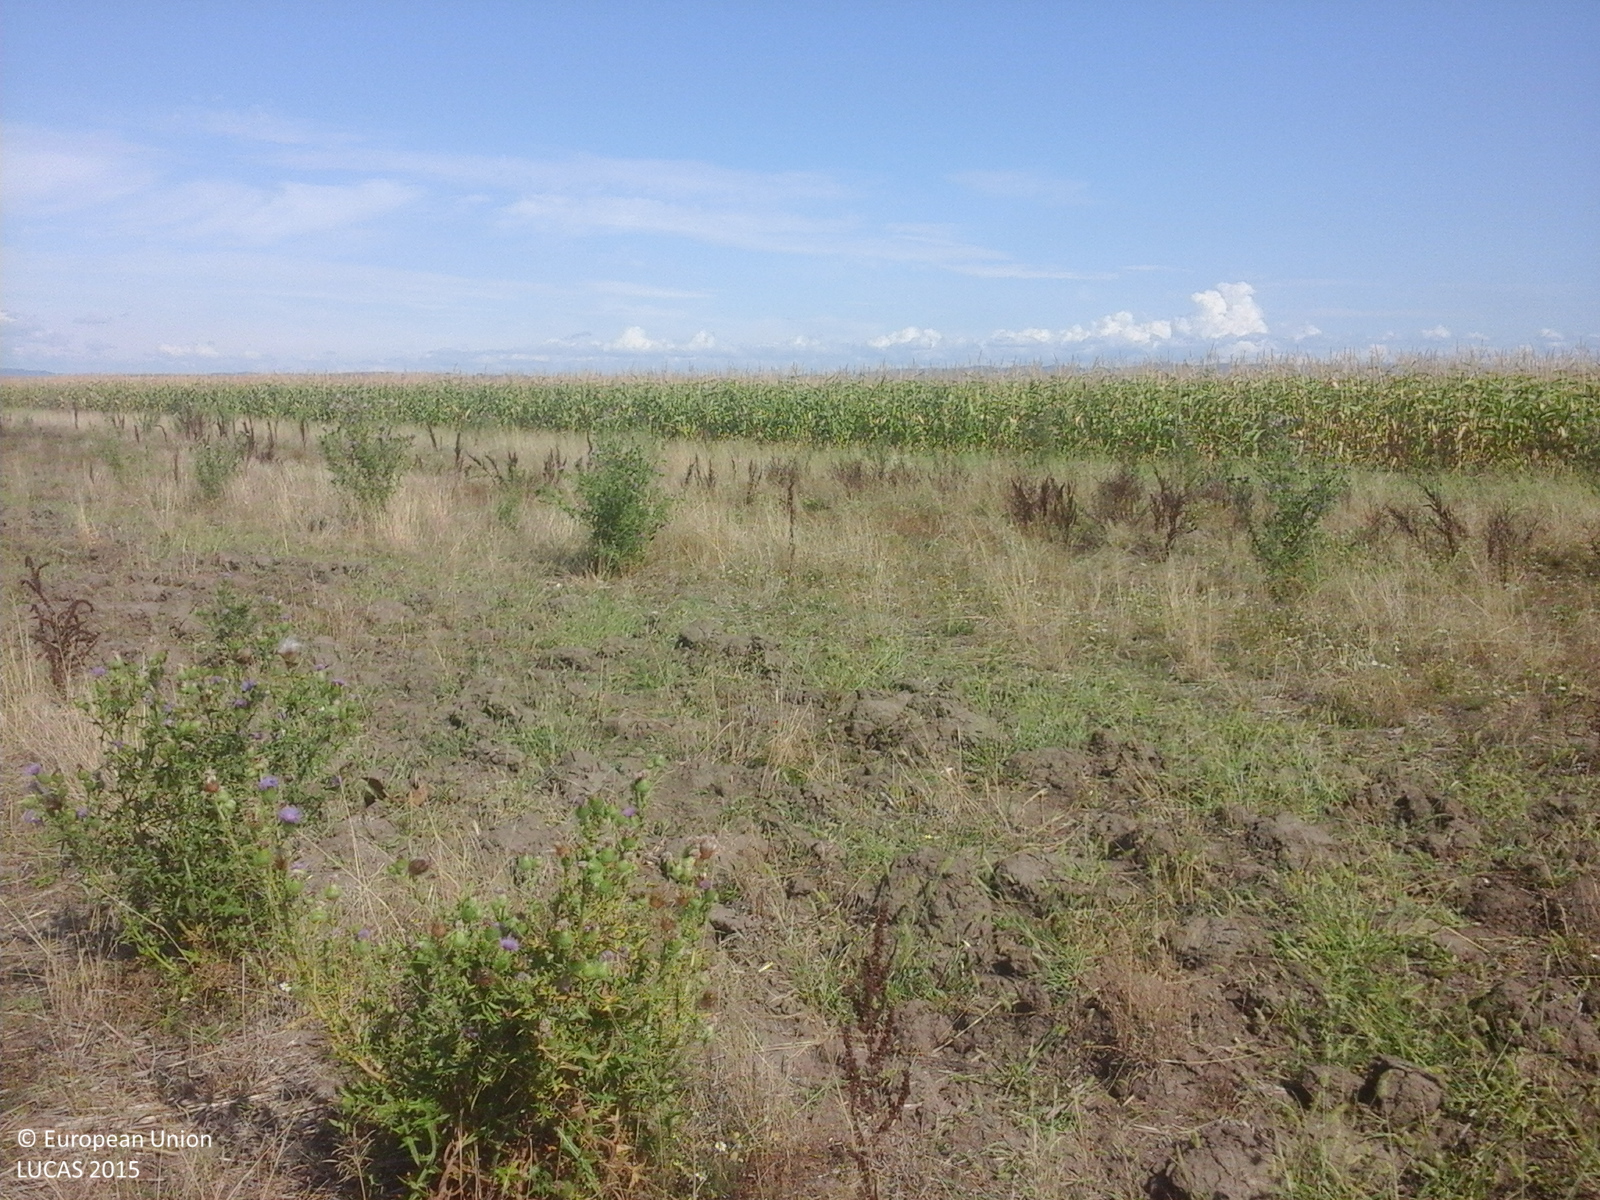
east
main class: Grassland
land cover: Spontaneously vegetated surfaces
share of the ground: > 75 %
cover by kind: herbaceous plants 100 %
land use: Fallow land
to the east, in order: Spontaneously vegetated surfaces; Maize
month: August
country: RO
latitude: 45.3517
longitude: 21.4548
